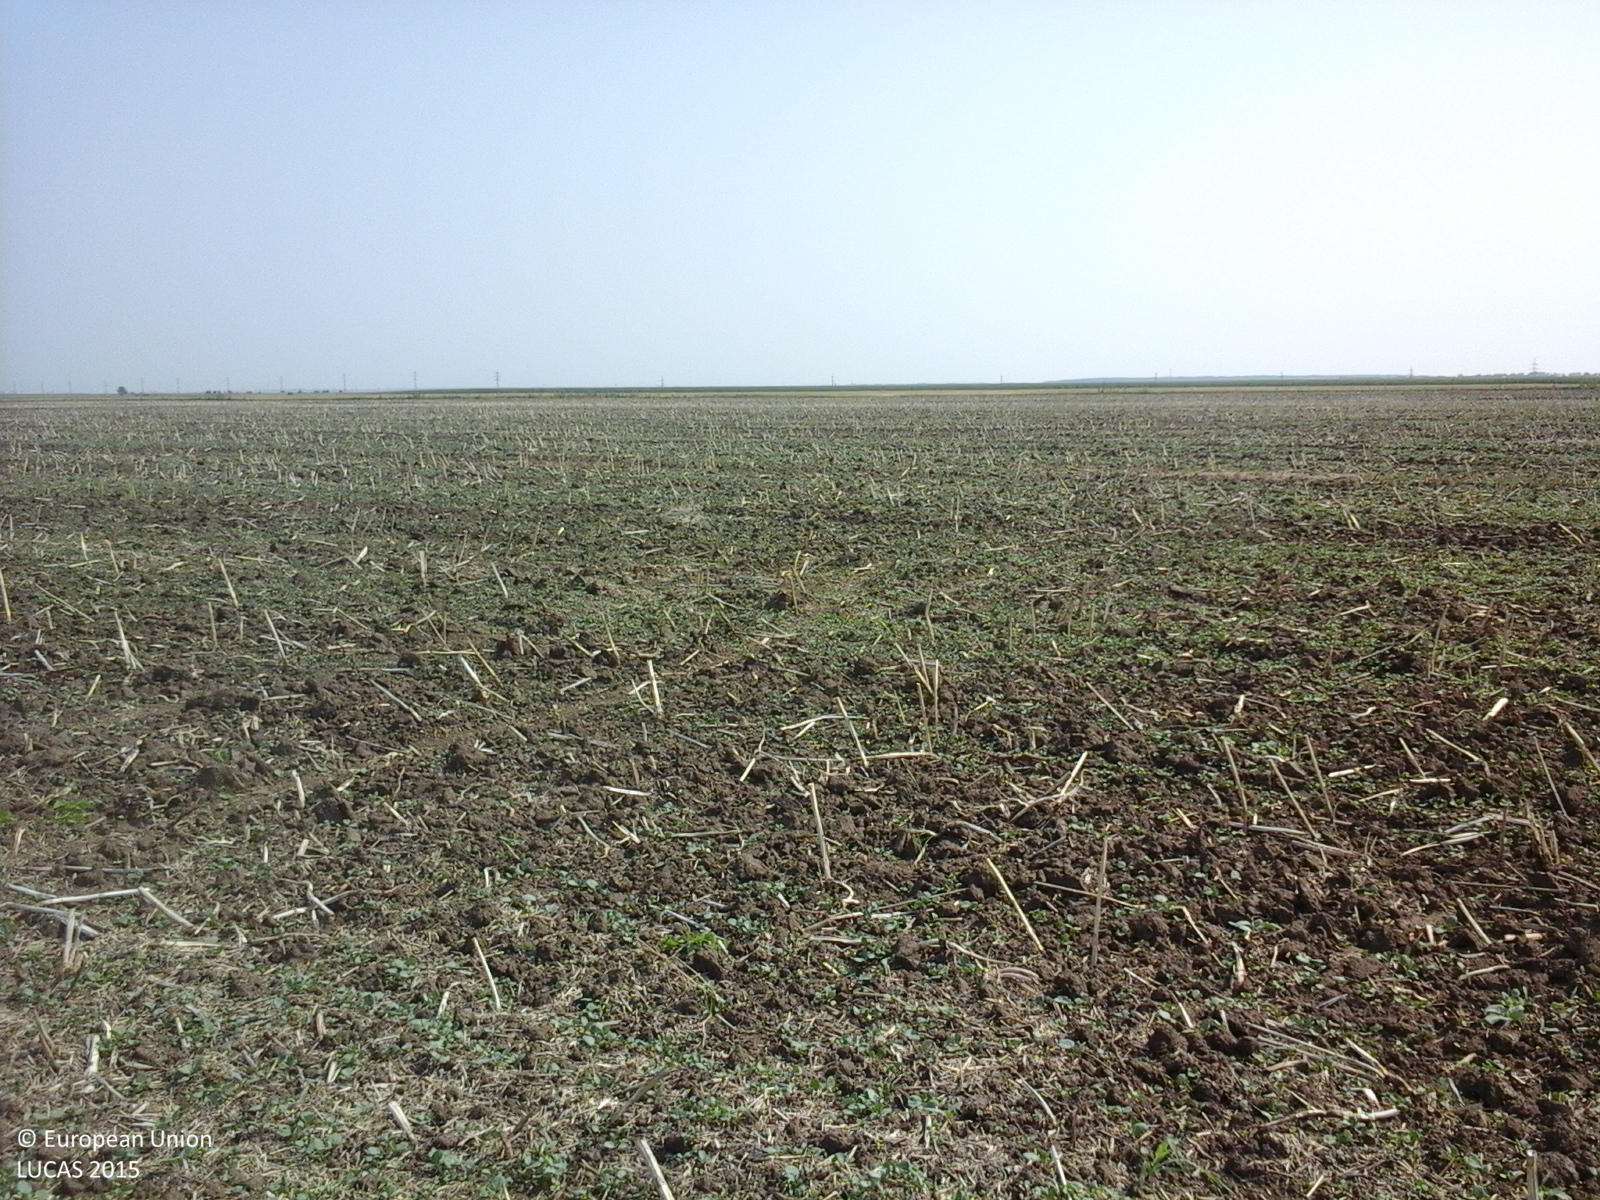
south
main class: Cropland
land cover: Rape and turnip rape
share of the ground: < 10 %
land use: Agriculture (excluding fallow land and kitchen gardens)
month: July
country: RO
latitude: 44.5630
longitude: 26.4965
